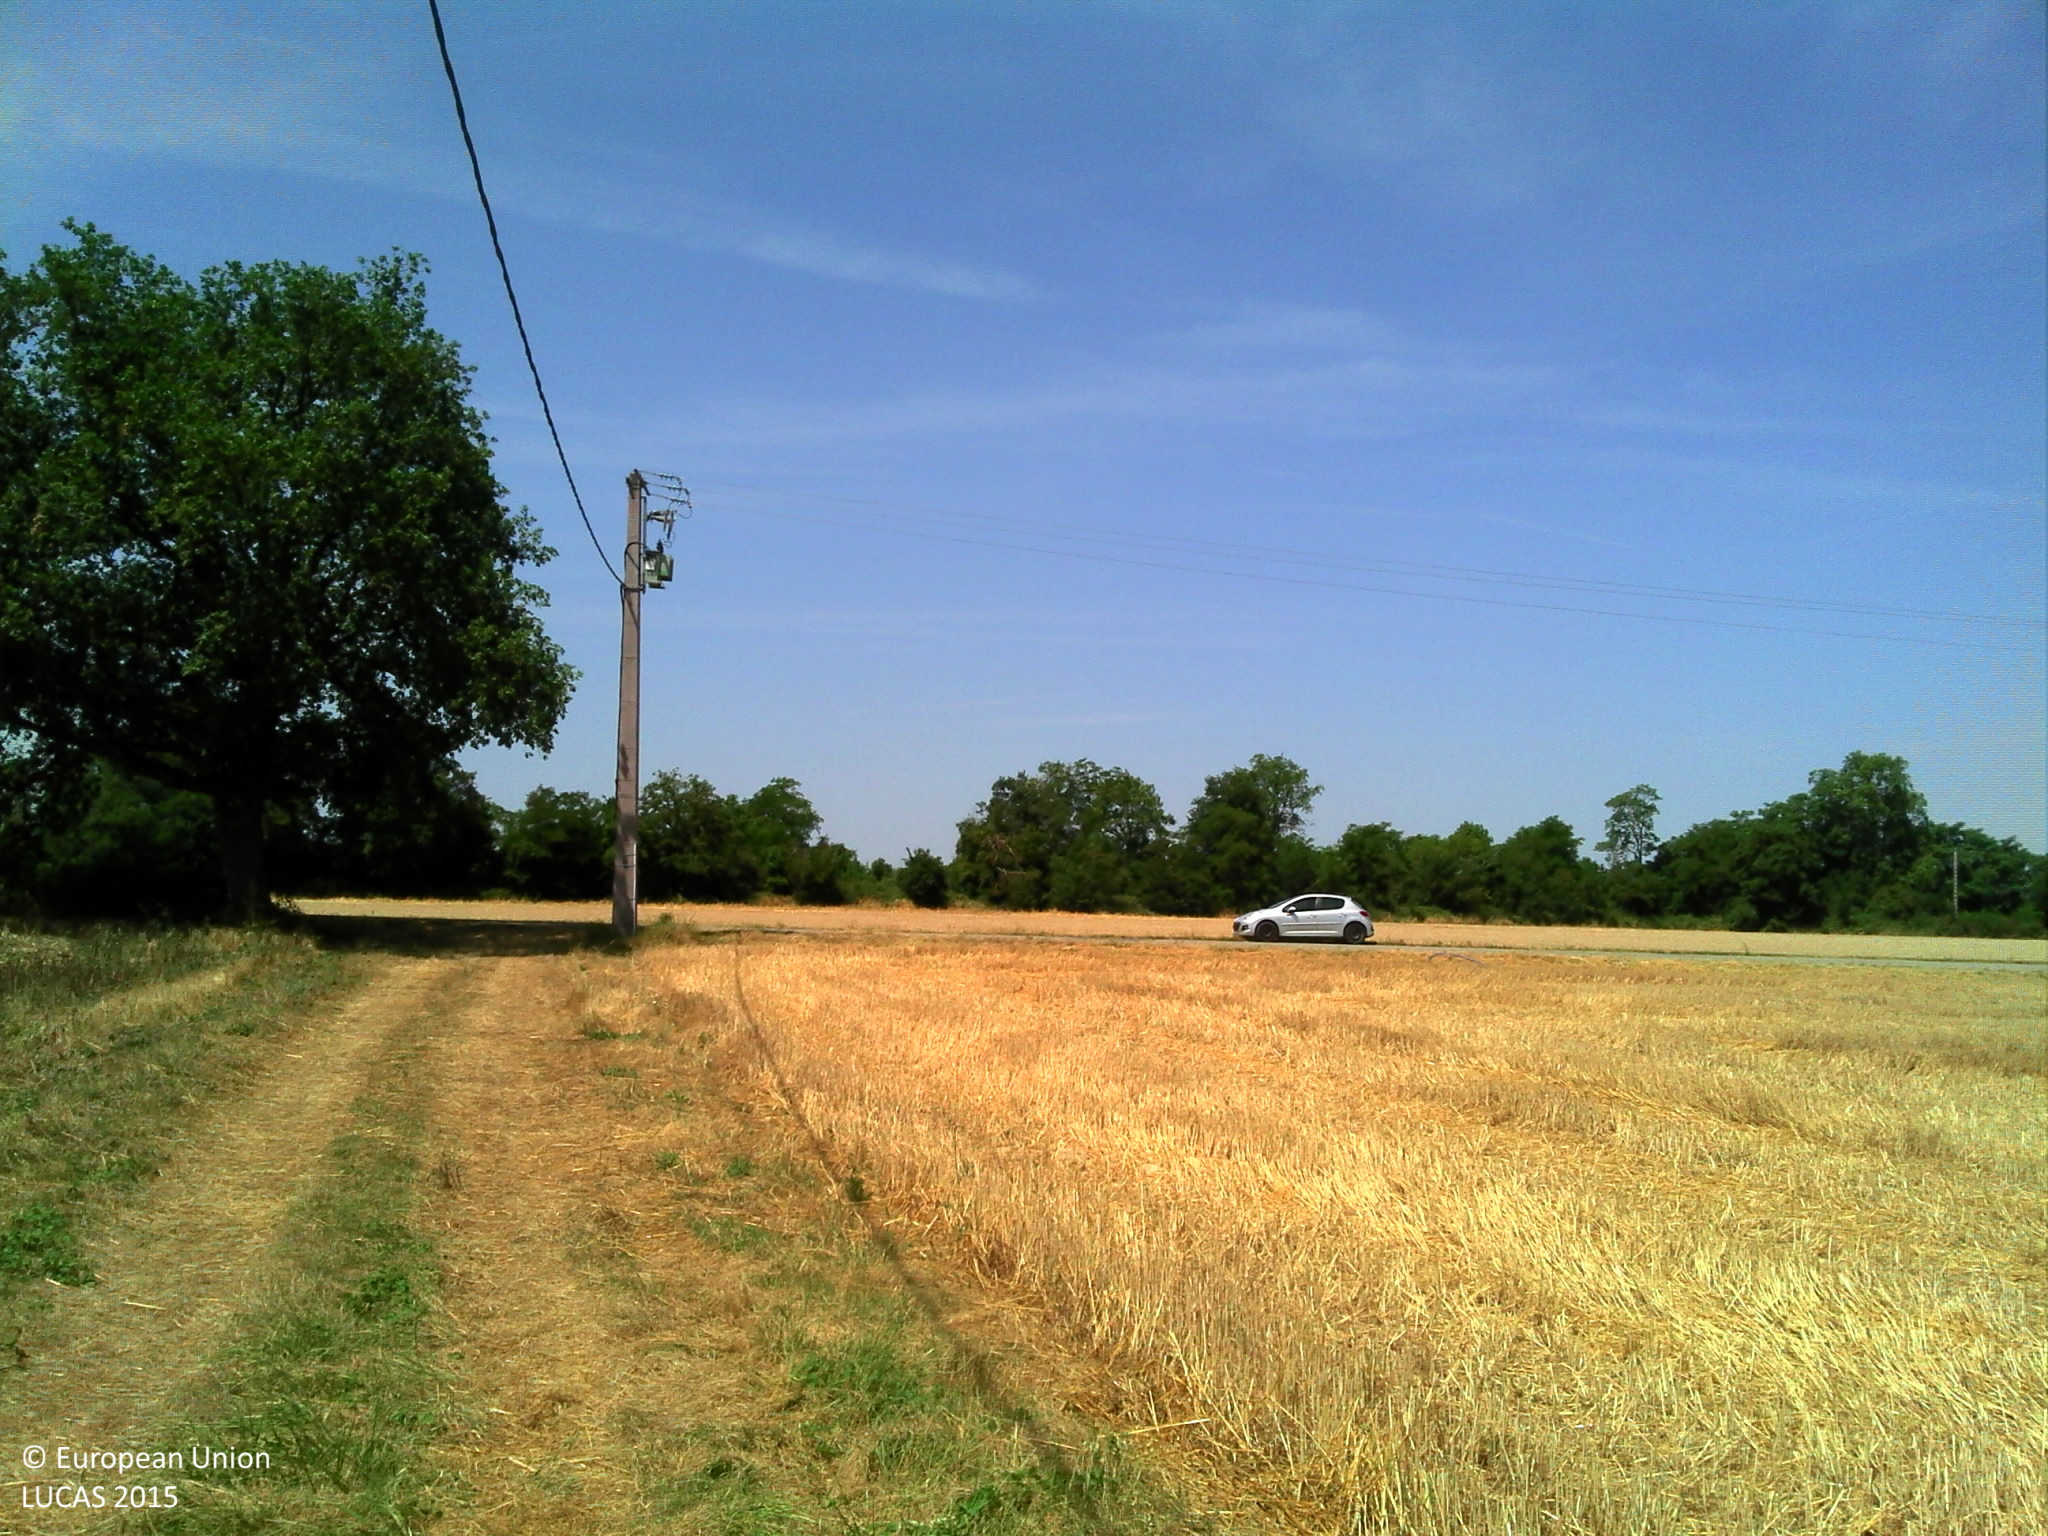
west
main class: Cropland
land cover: Common wheat
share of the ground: > 75 %
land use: Agriculture (excluding fallow land and kitchen gardens)
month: July
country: FR
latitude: 43.1419
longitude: 1.6331
